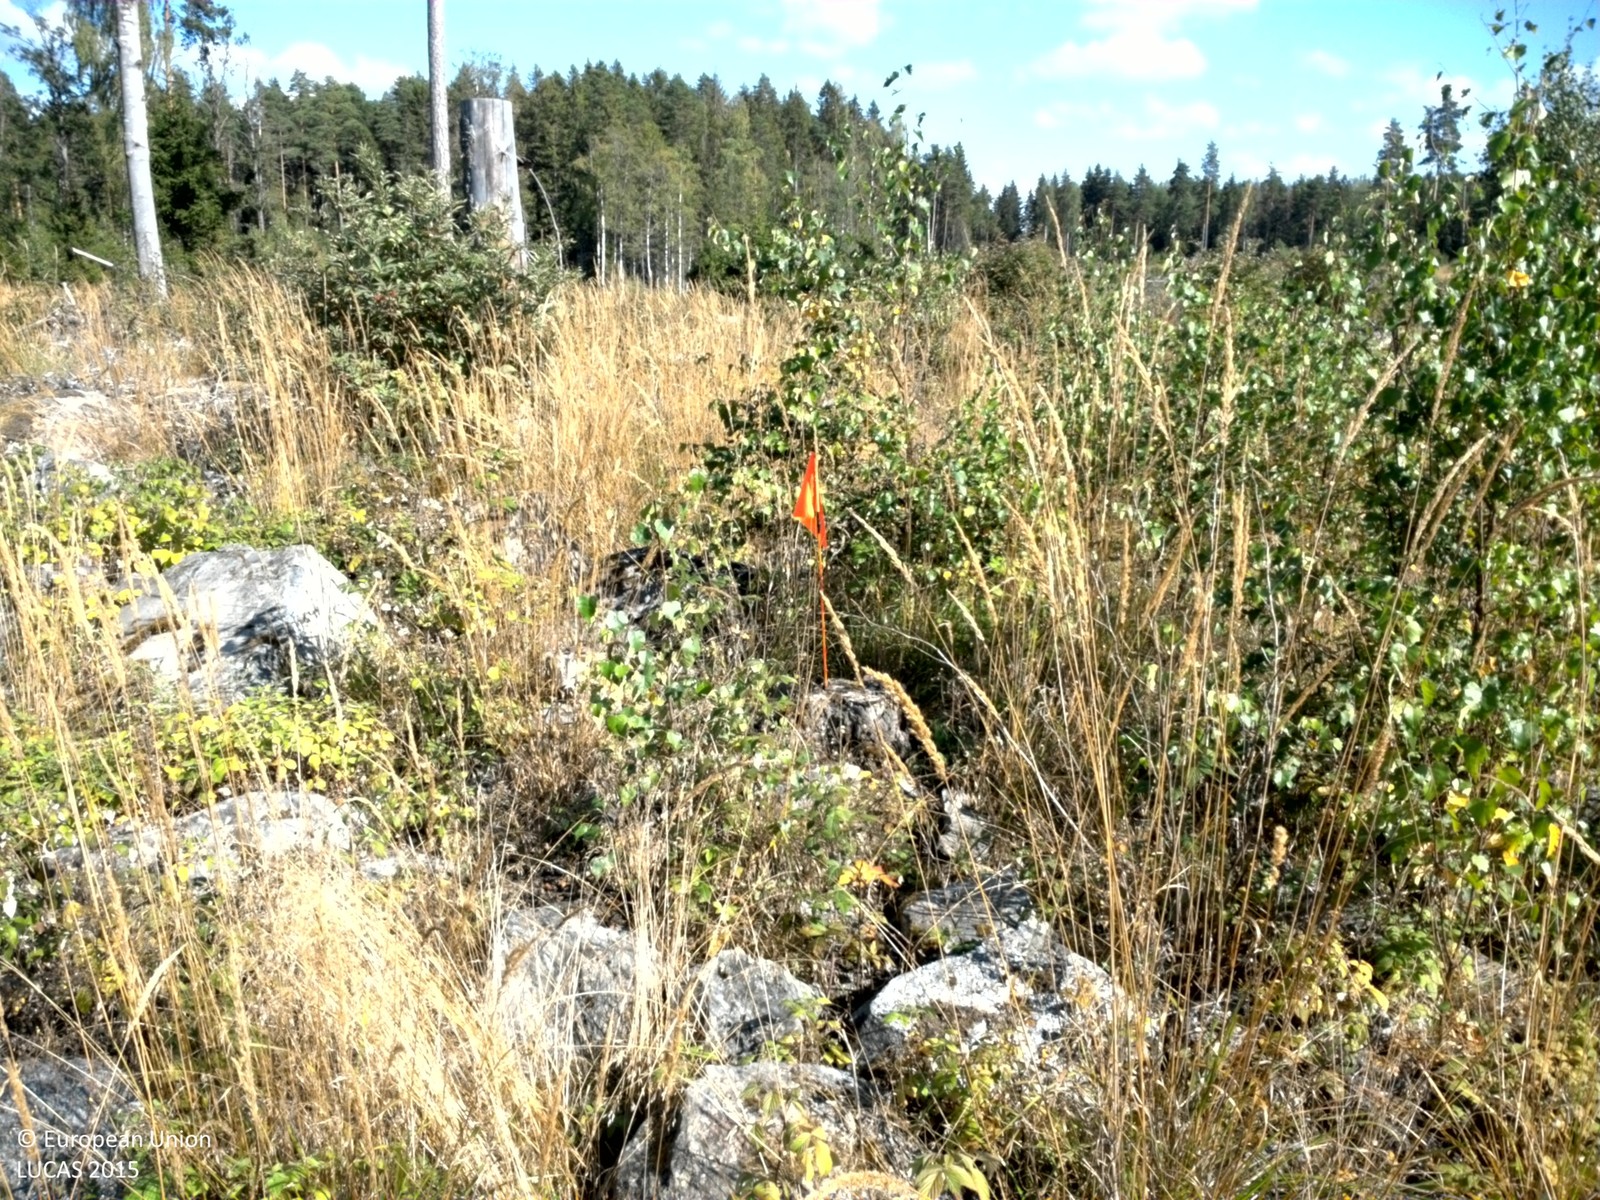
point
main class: Woodland
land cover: Broadleaved woodland
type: boreal forest
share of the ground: 25 - 50 %
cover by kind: herbaceous plants 45 %, broadleaved forest trees 30 %, shrubs 15 %, coniferous forest trees 5 %, consolidated bare surface 5 %
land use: Forestry
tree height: < 5 m
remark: Clear cut
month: August
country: SE
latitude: 60.0964
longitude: 17.7080
